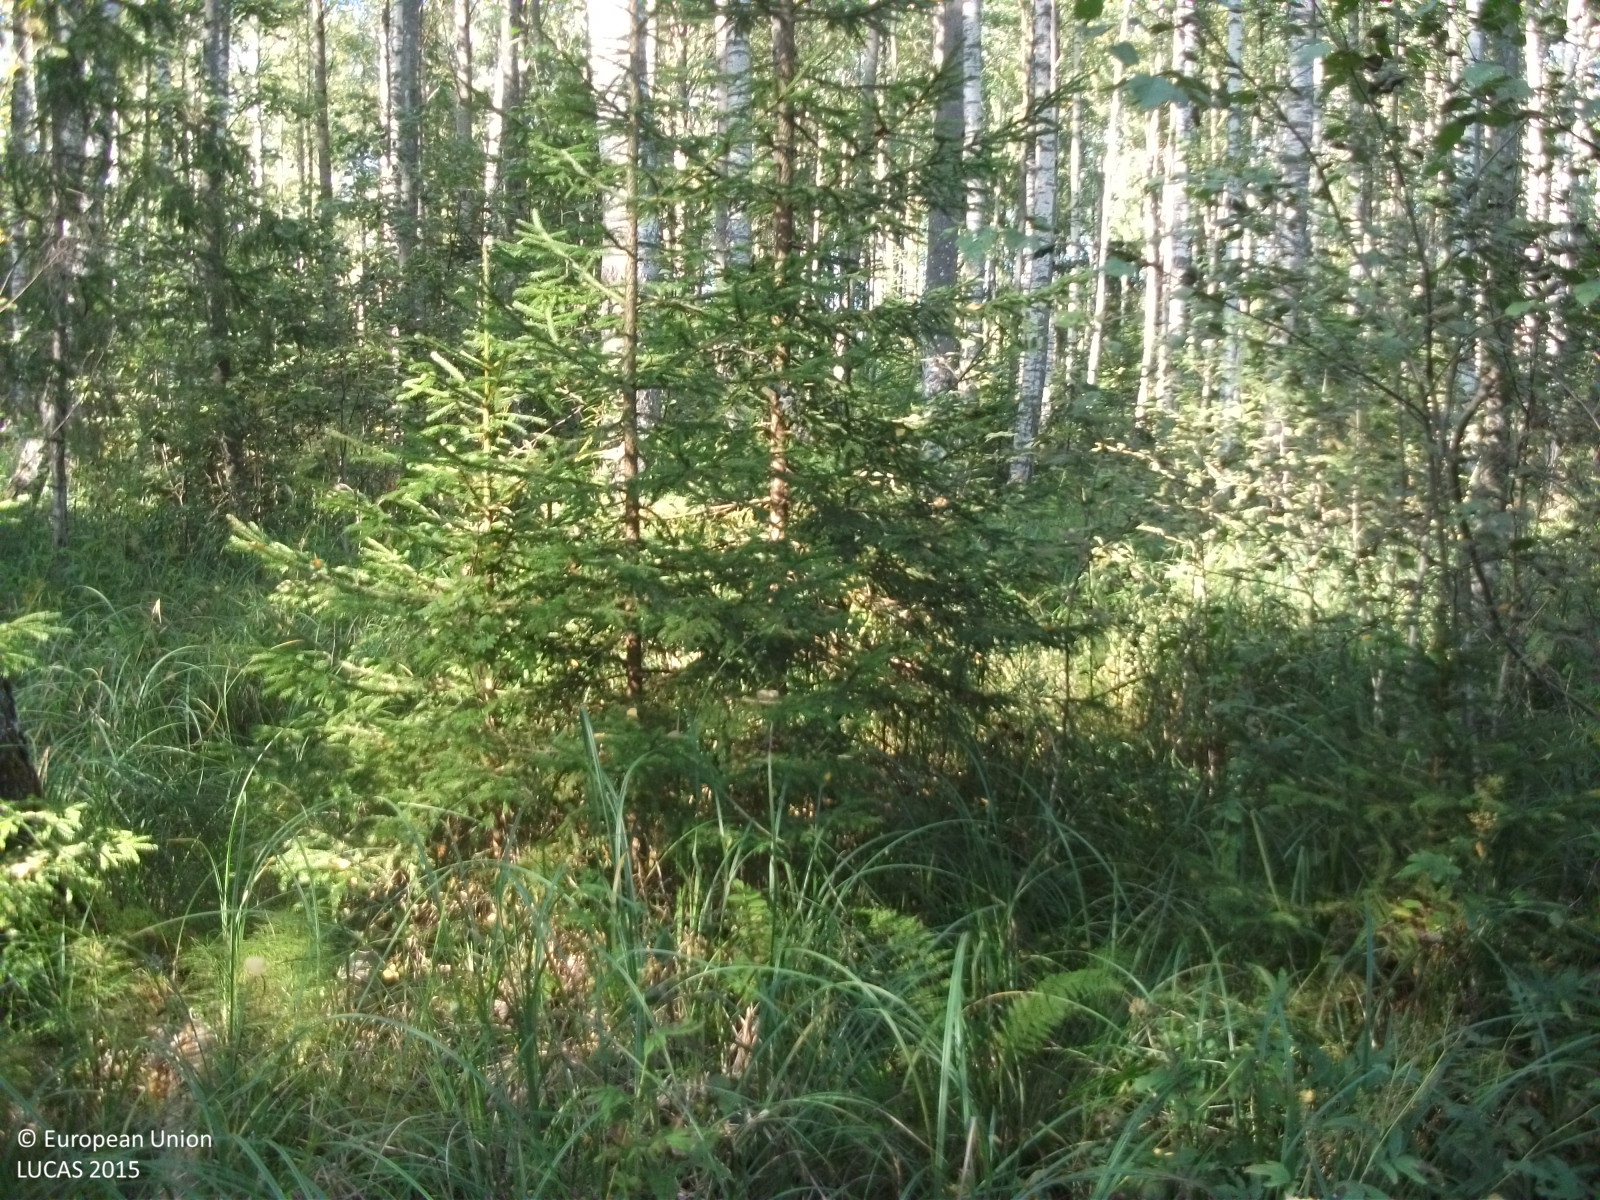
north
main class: Woodland
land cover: Spruce dominated mixed woodland
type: hemiboreal forest and nemoral coniferous forest and mixed broadleaved-coniferous forest
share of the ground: > 75 %
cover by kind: broadleaved forest trees 55 %, coniferous forest trees 30 %, herbaceous plants 10 %, shrubs 5 %
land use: Forestry
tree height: > 5 m
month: September
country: LV
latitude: 58.0116
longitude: 25.0106
